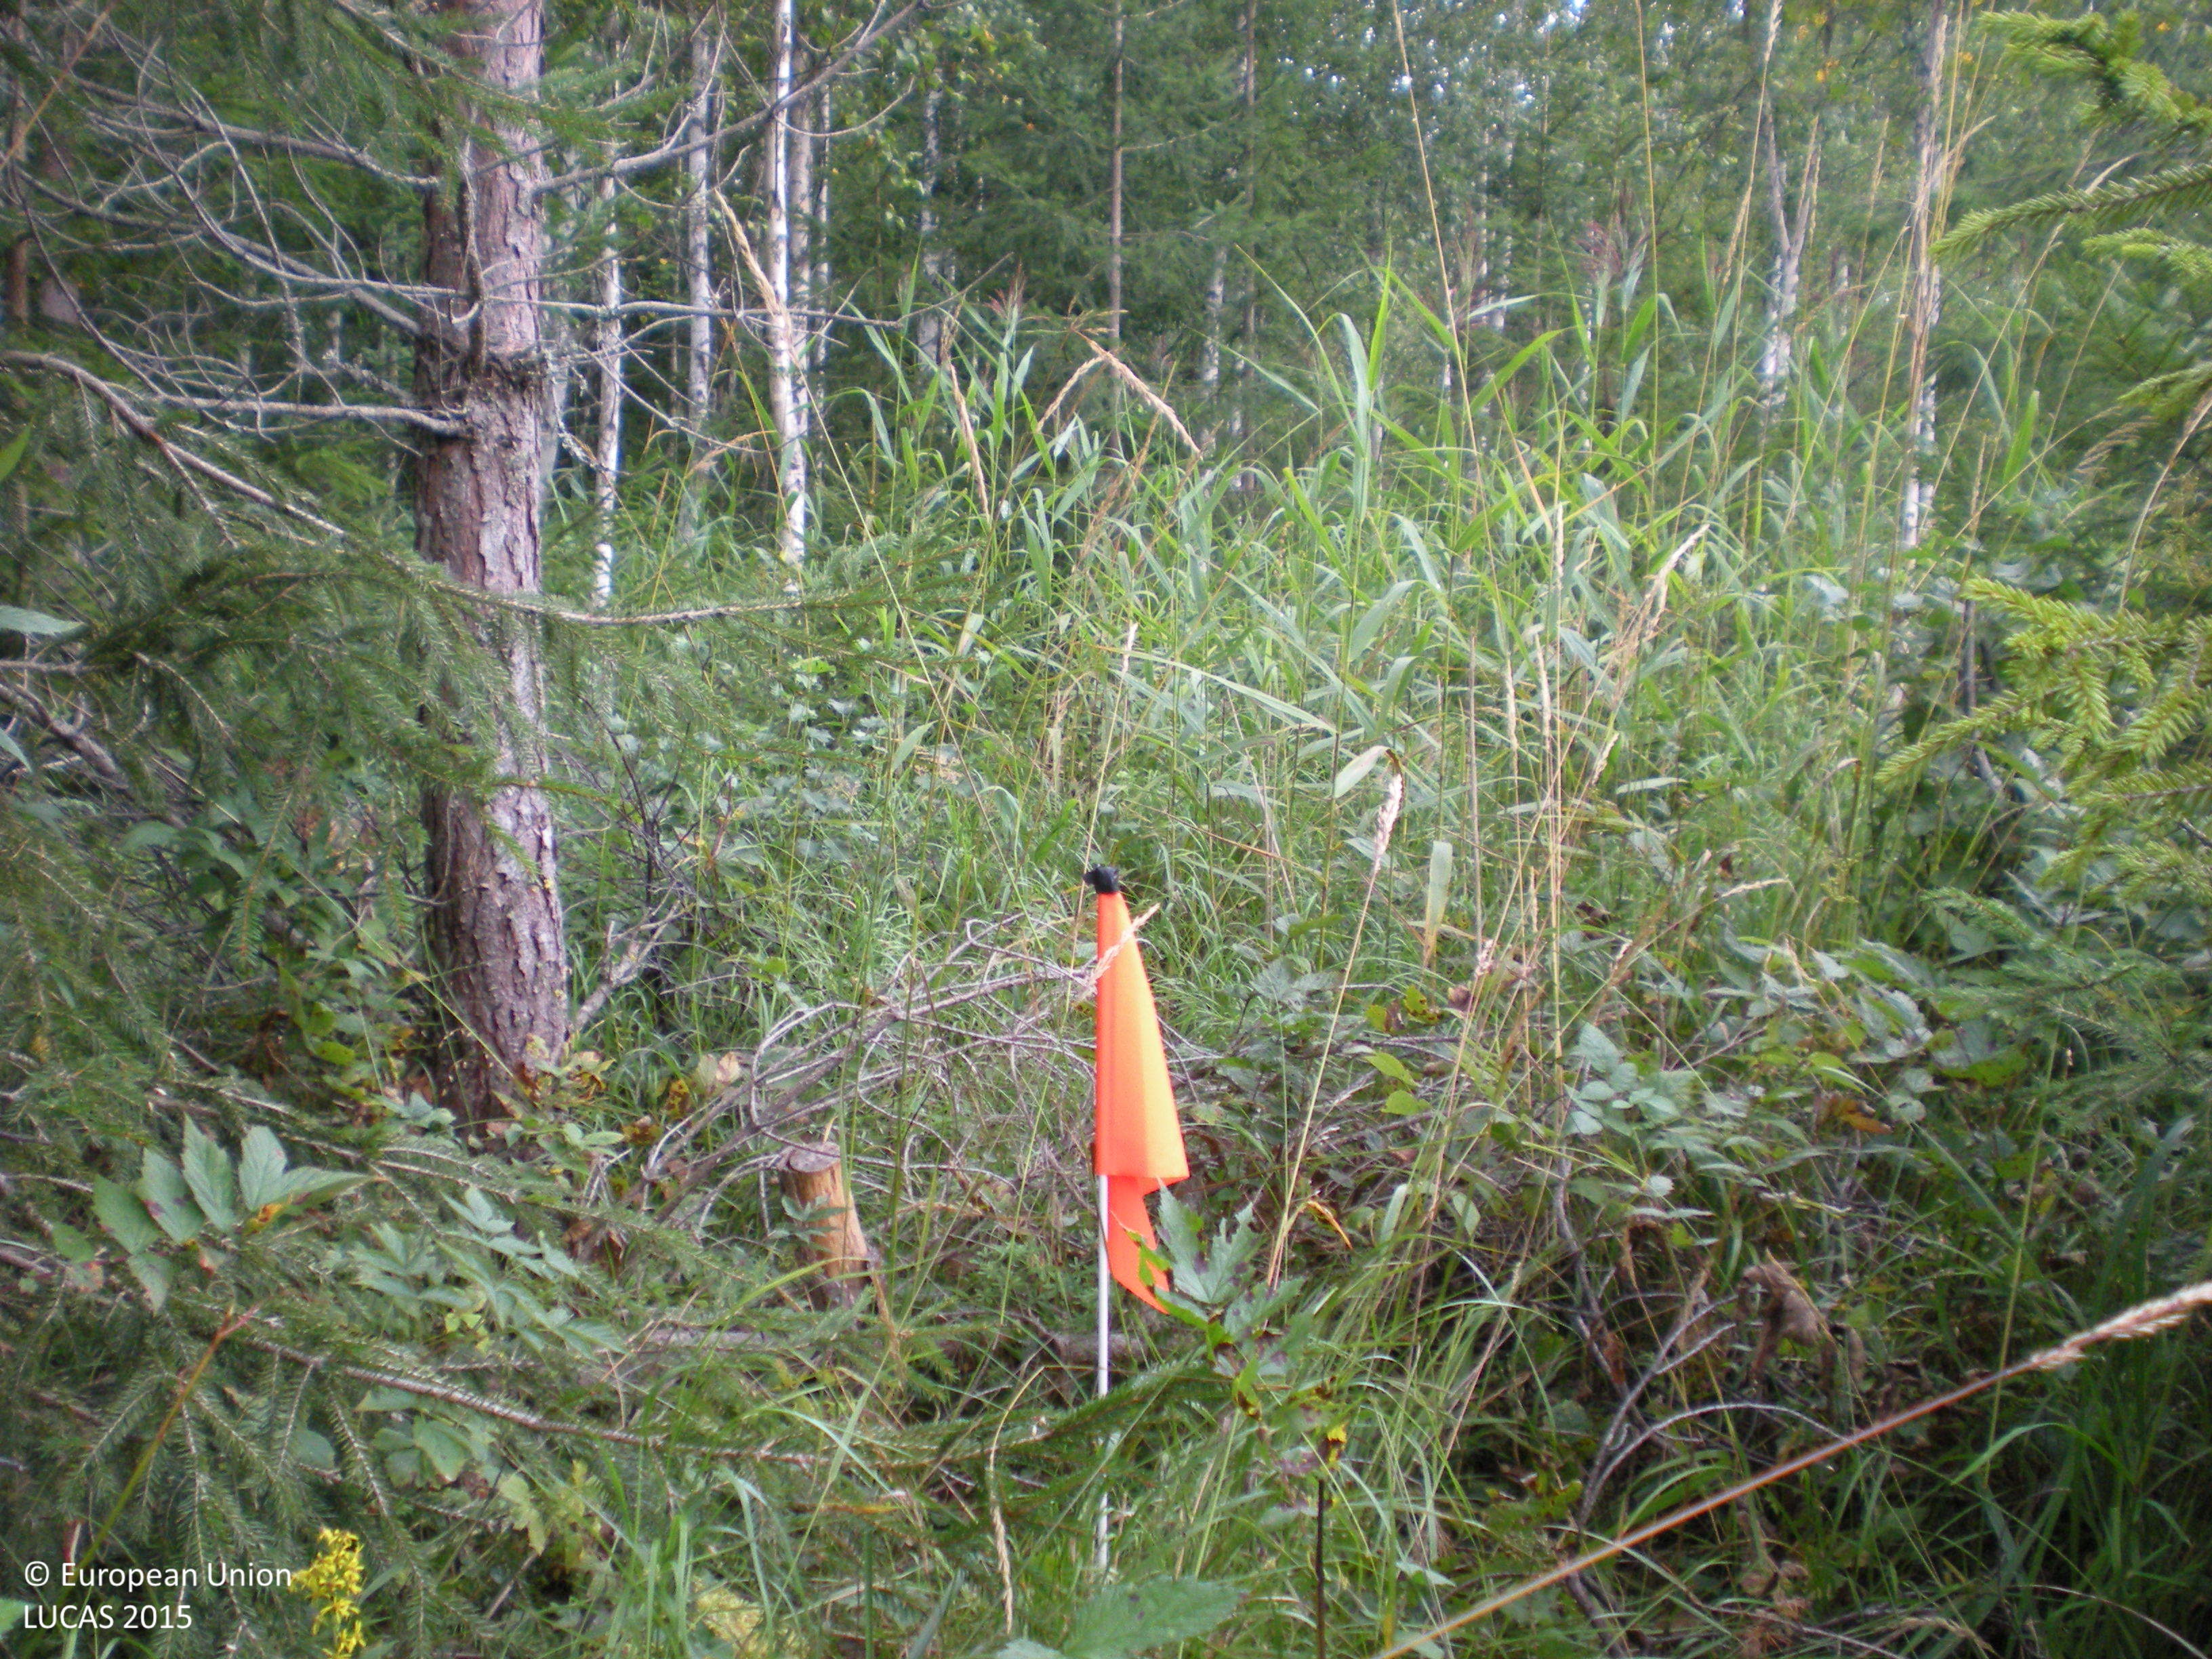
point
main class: Woodland
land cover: Spruce dominated mixed woodland
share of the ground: 50 - 75 %
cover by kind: coniferous forest trees 55 %, herbaceous plants 25 %, broadleaved forest trees 20 %
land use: Forestry
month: August
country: SE
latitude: 60.5256
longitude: 17.1136
